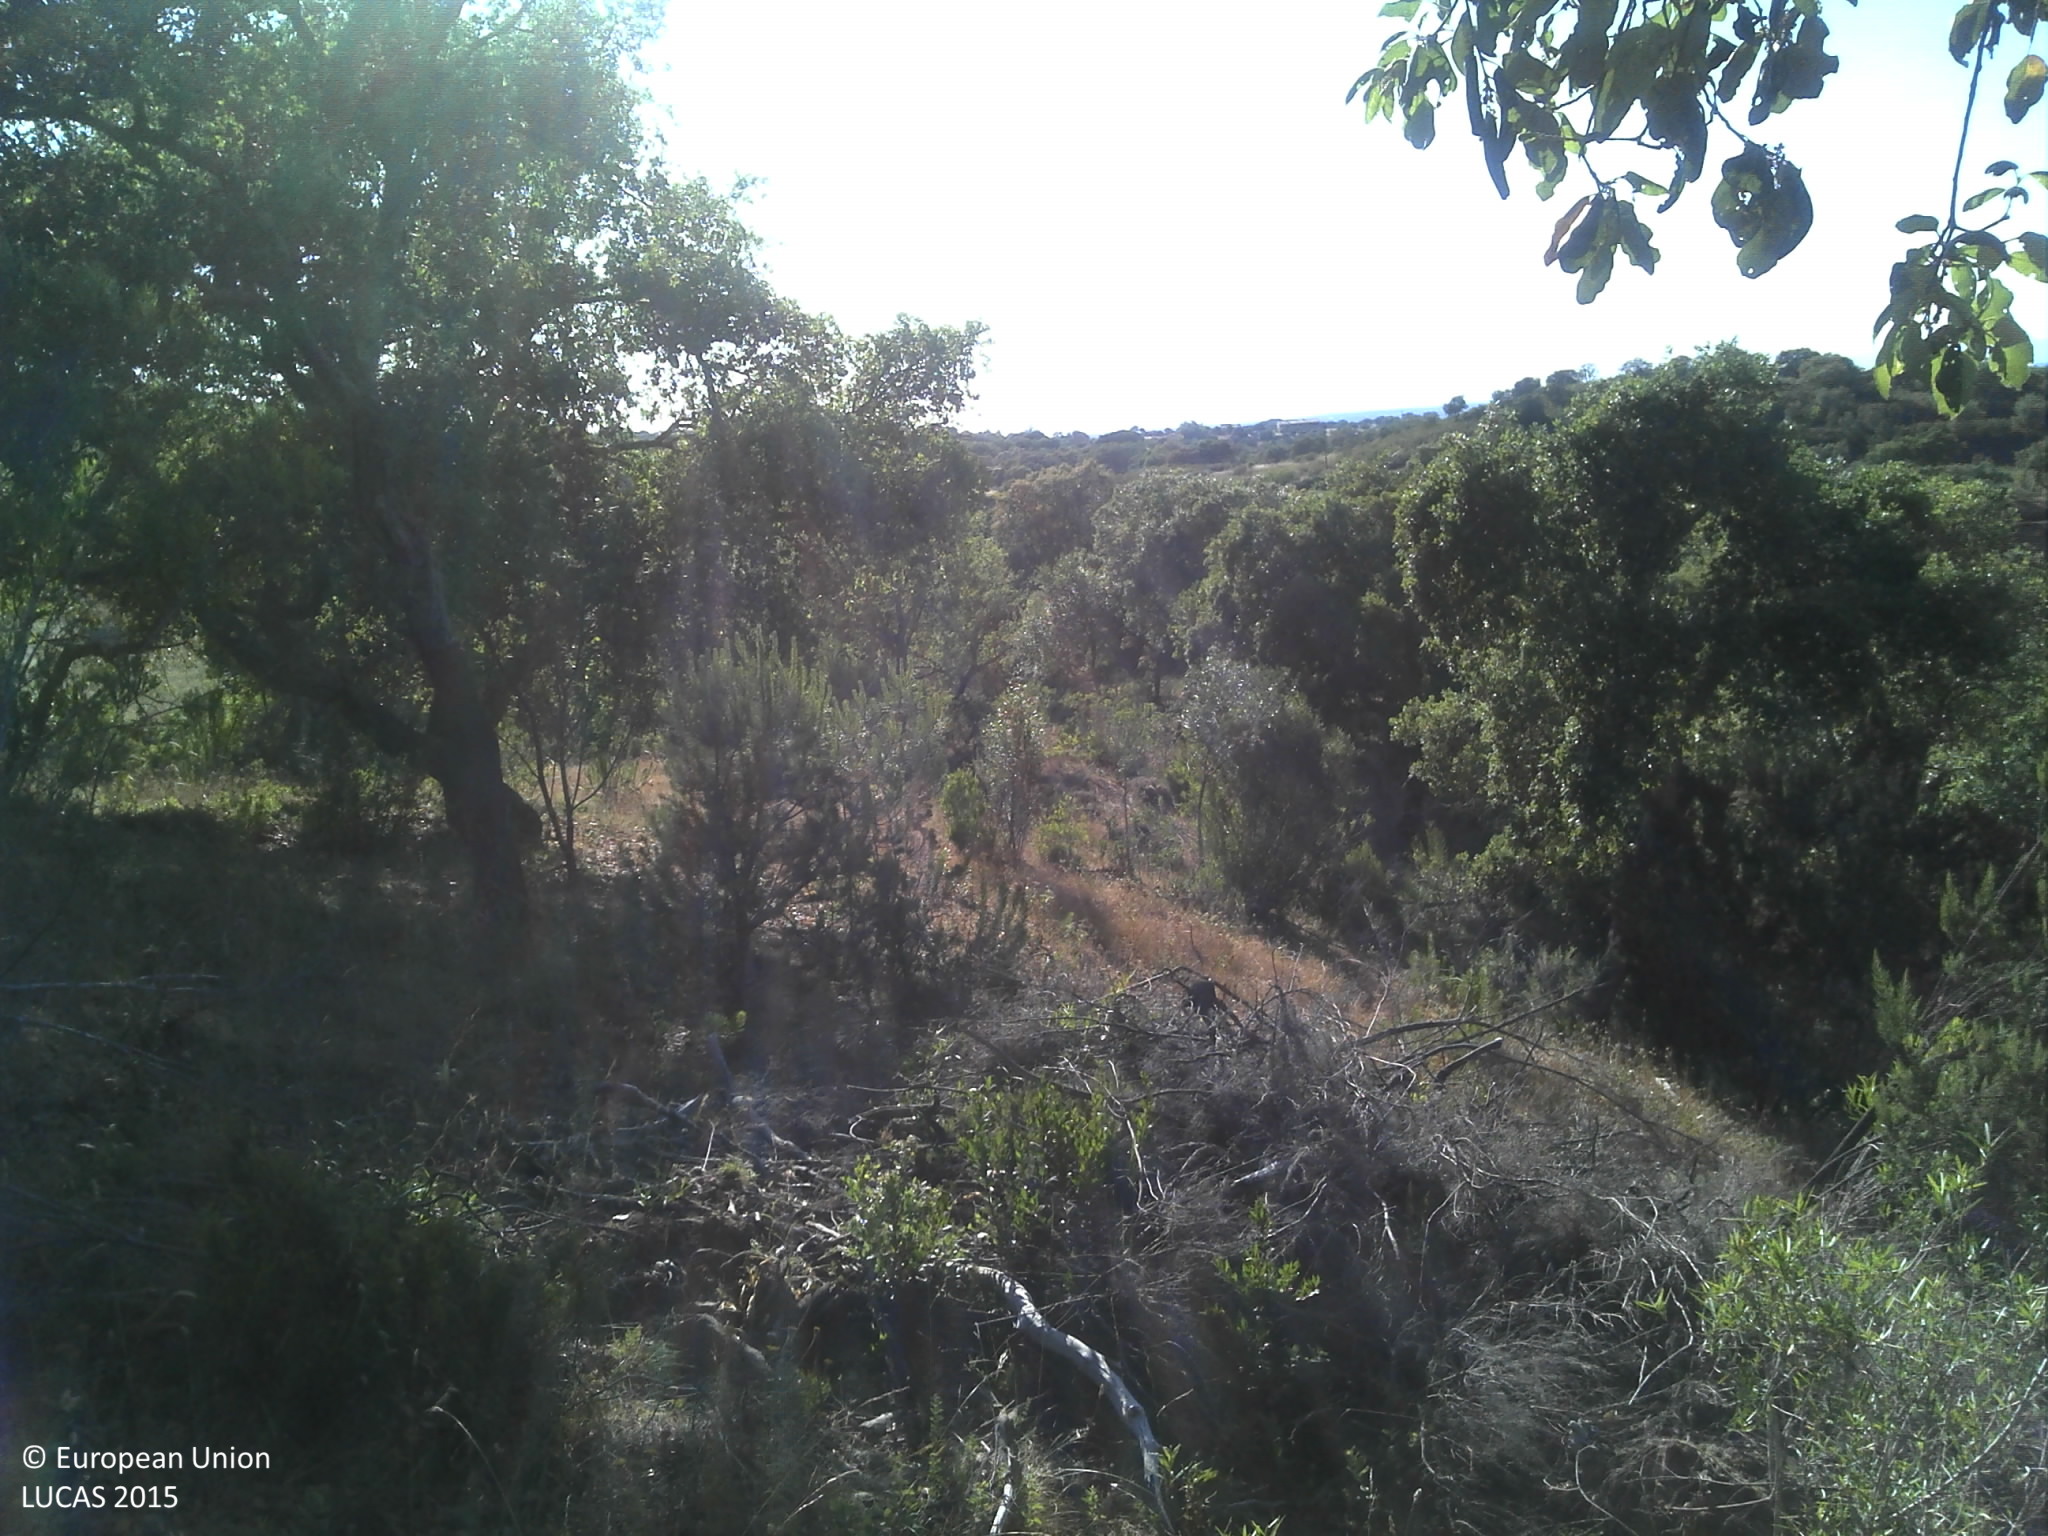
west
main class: Woodland
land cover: Broadleaved woodland
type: broadleaved evergreen forest
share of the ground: 50 - 75 %
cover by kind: broadleaved forest trees 60 %, herbaceous plants 20 %, unconsolidated bare surface 20 %
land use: Forestry
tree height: > 5 m
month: May
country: PT
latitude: 38.1880
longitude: -8.6259
